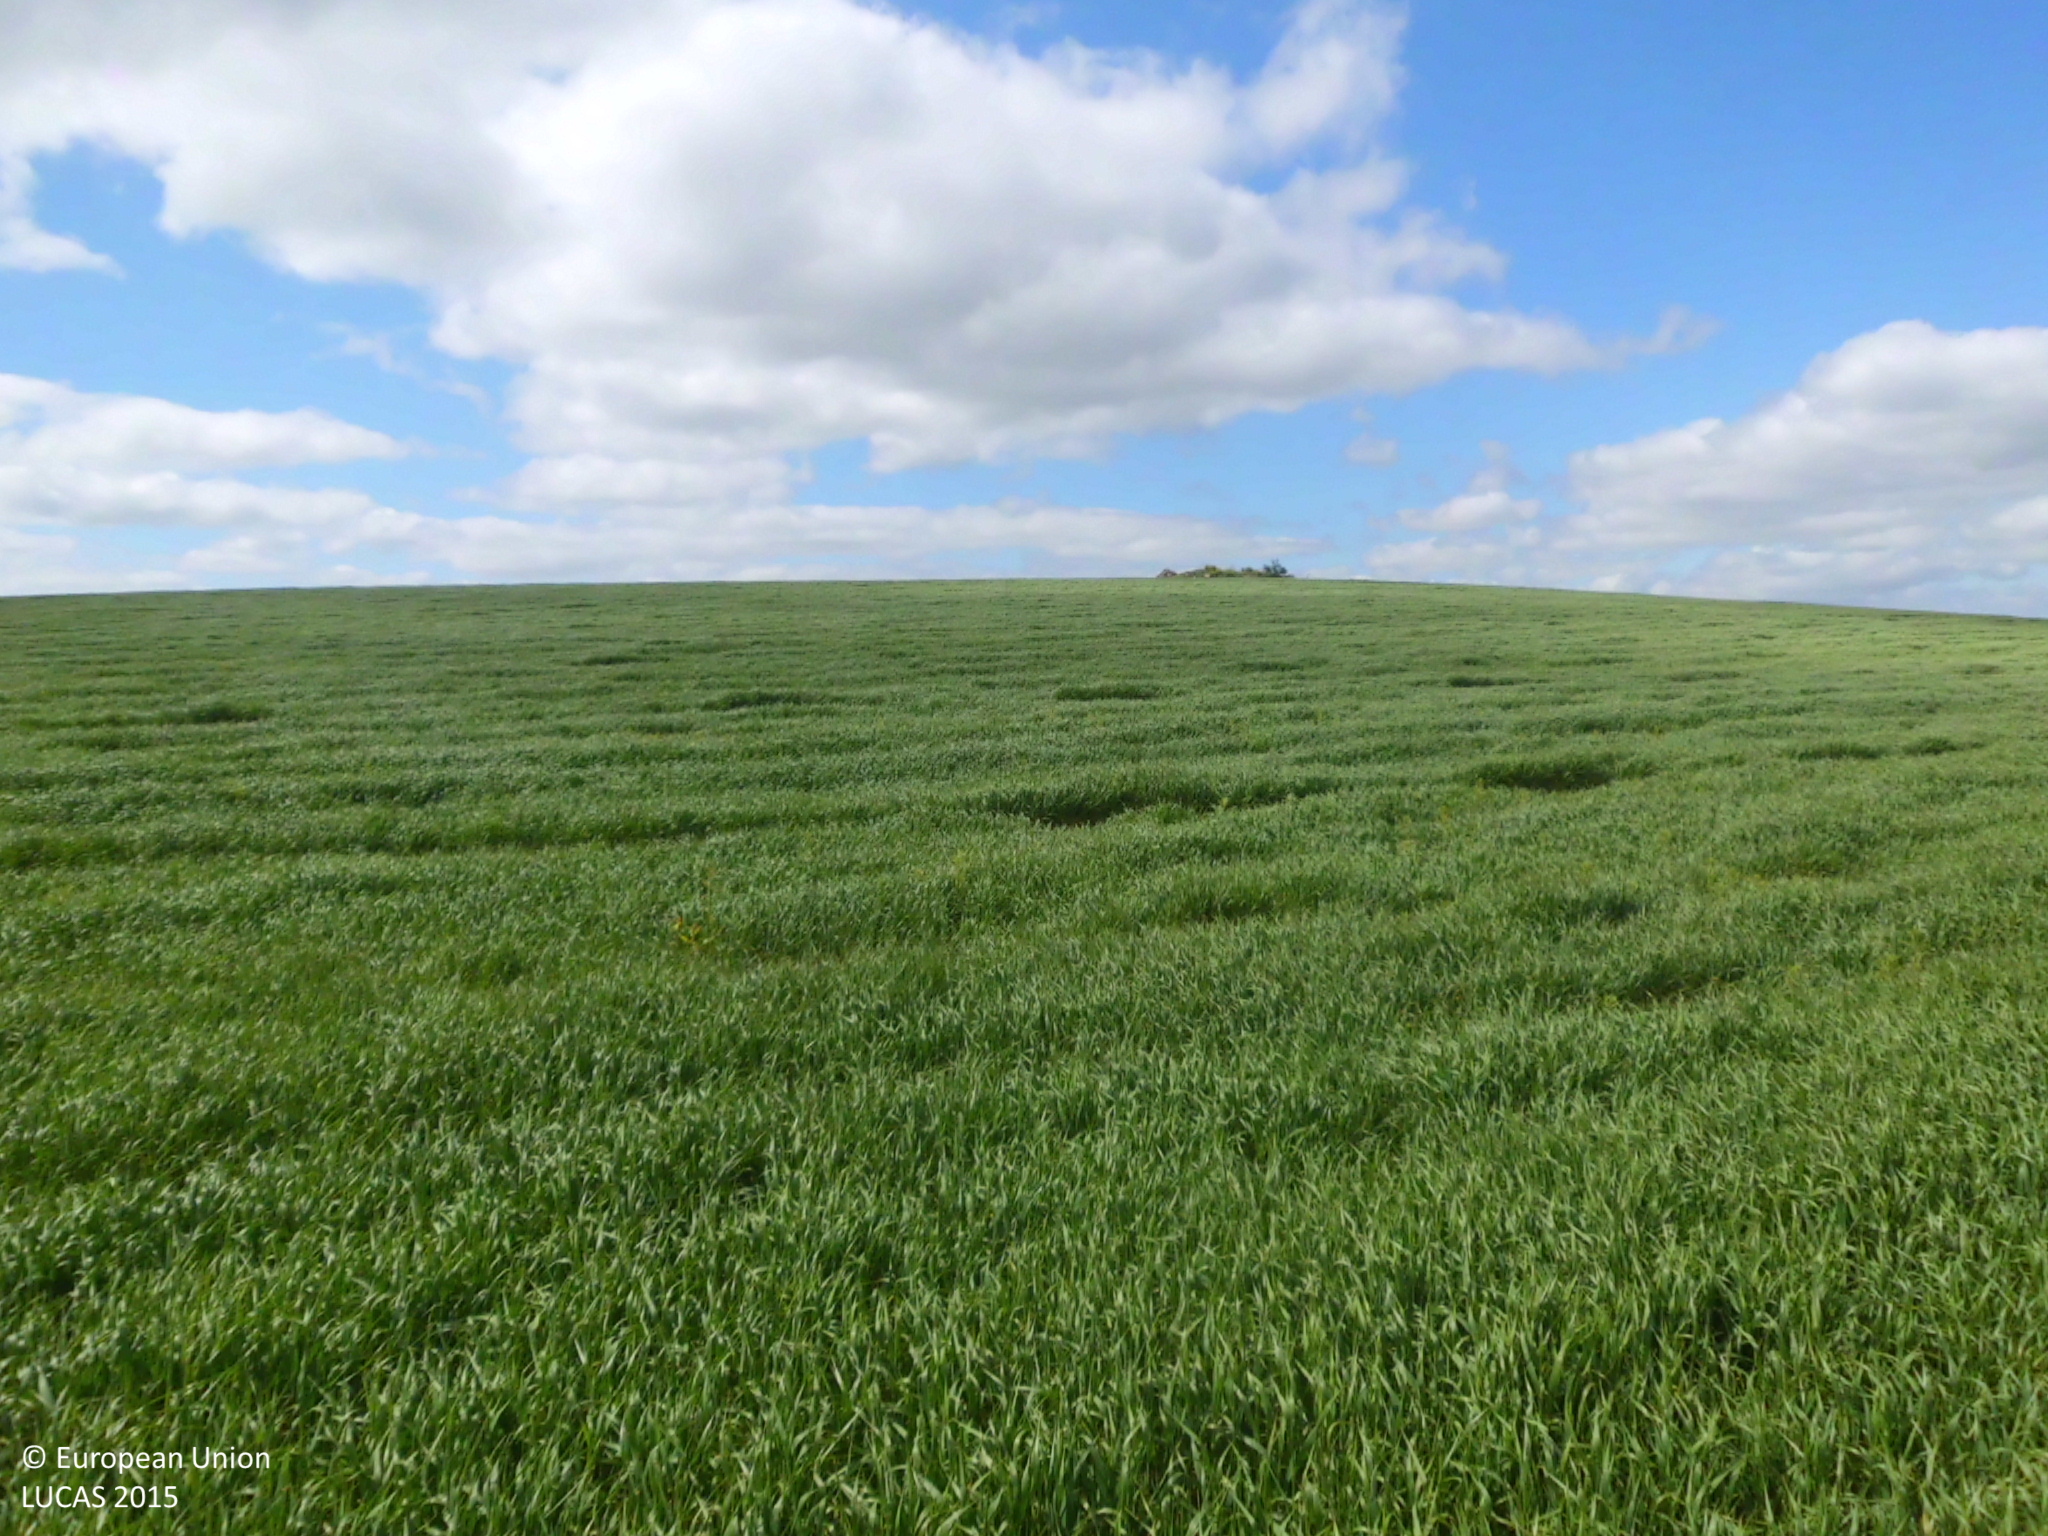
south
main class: Cropland
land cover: Barley
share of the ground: > 75 %
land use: Agriculture (excluding fallow land and kitchen gardens)
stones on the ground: 10 - 25 %
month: May
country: ES
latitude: 42.3648
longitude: -3.9186
